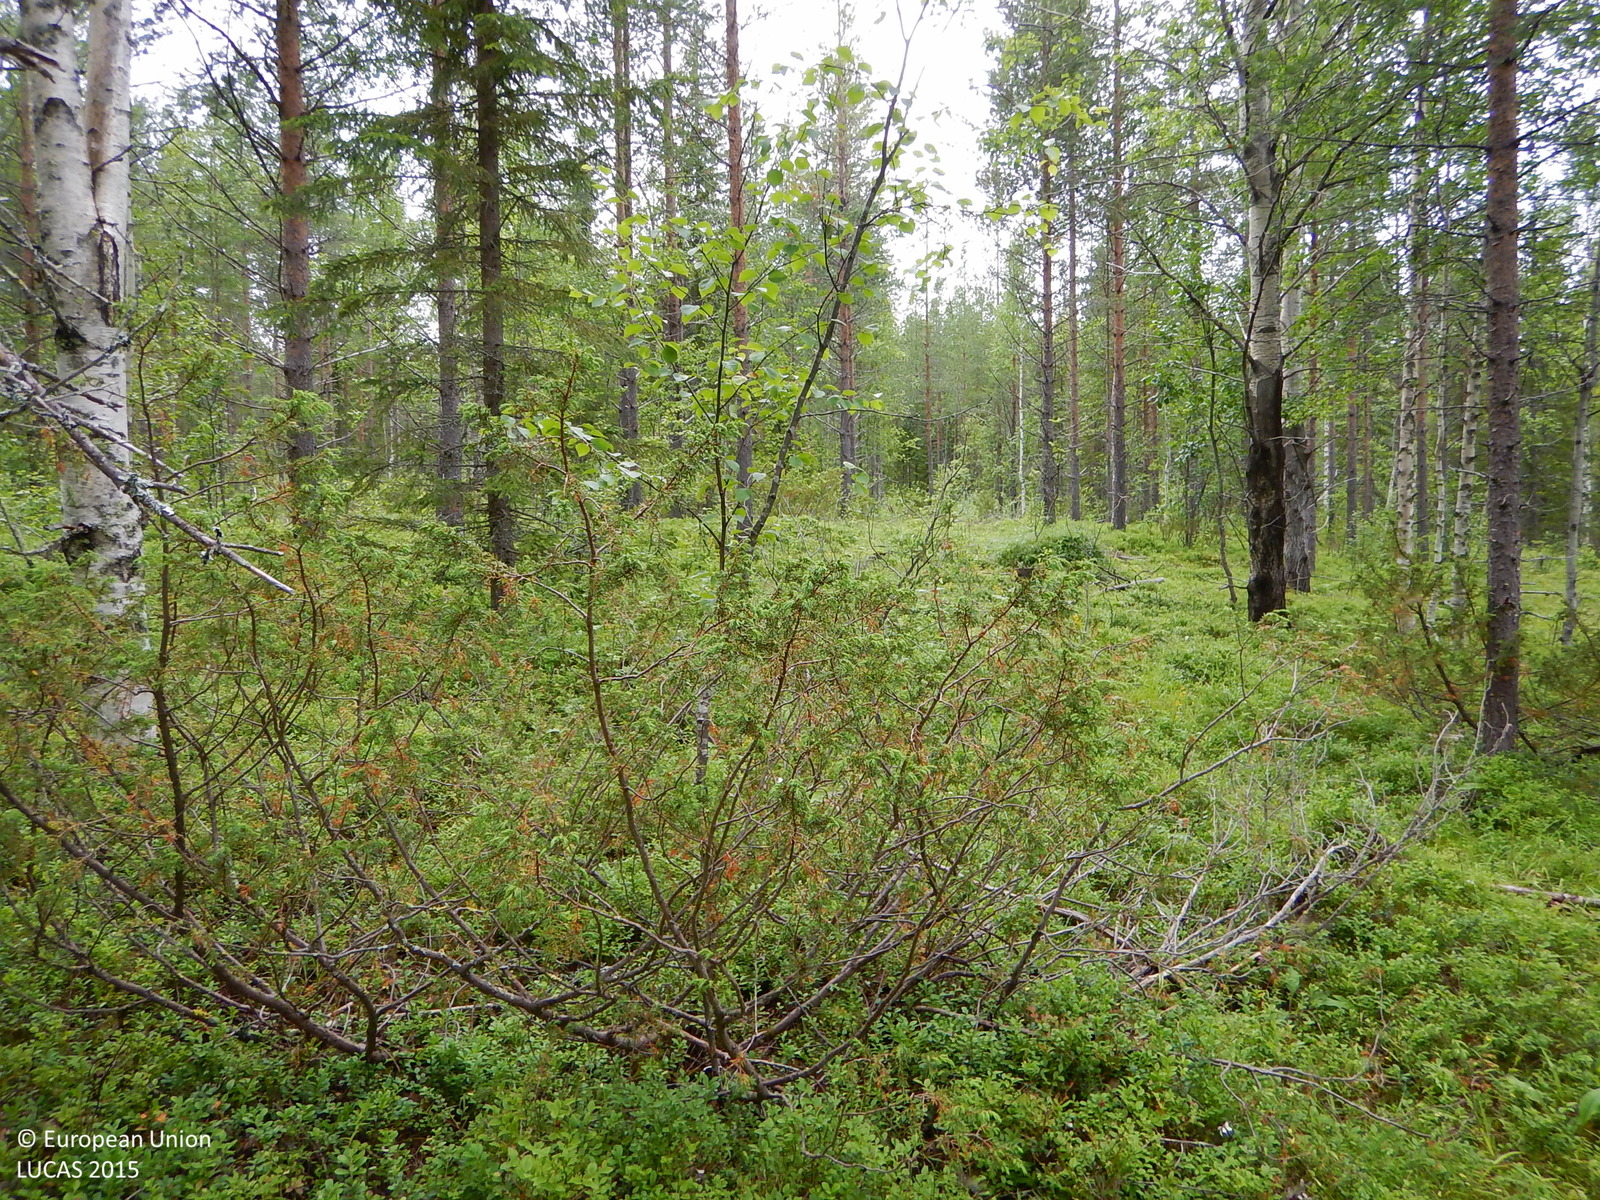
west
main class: Woodland
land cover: Pine dominated mixed woodland
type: boreal forest
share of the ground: 25 - 50 %
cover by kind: shrubs 35 %, coniferous forest trees 30 %, herbaceous plants 15 %, broadleaved forest trees 10 %, lichens and mosses 10 %
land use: Forestry
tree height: > 5 m
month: July
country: SE
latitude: 64.9113
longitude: 20.4353
